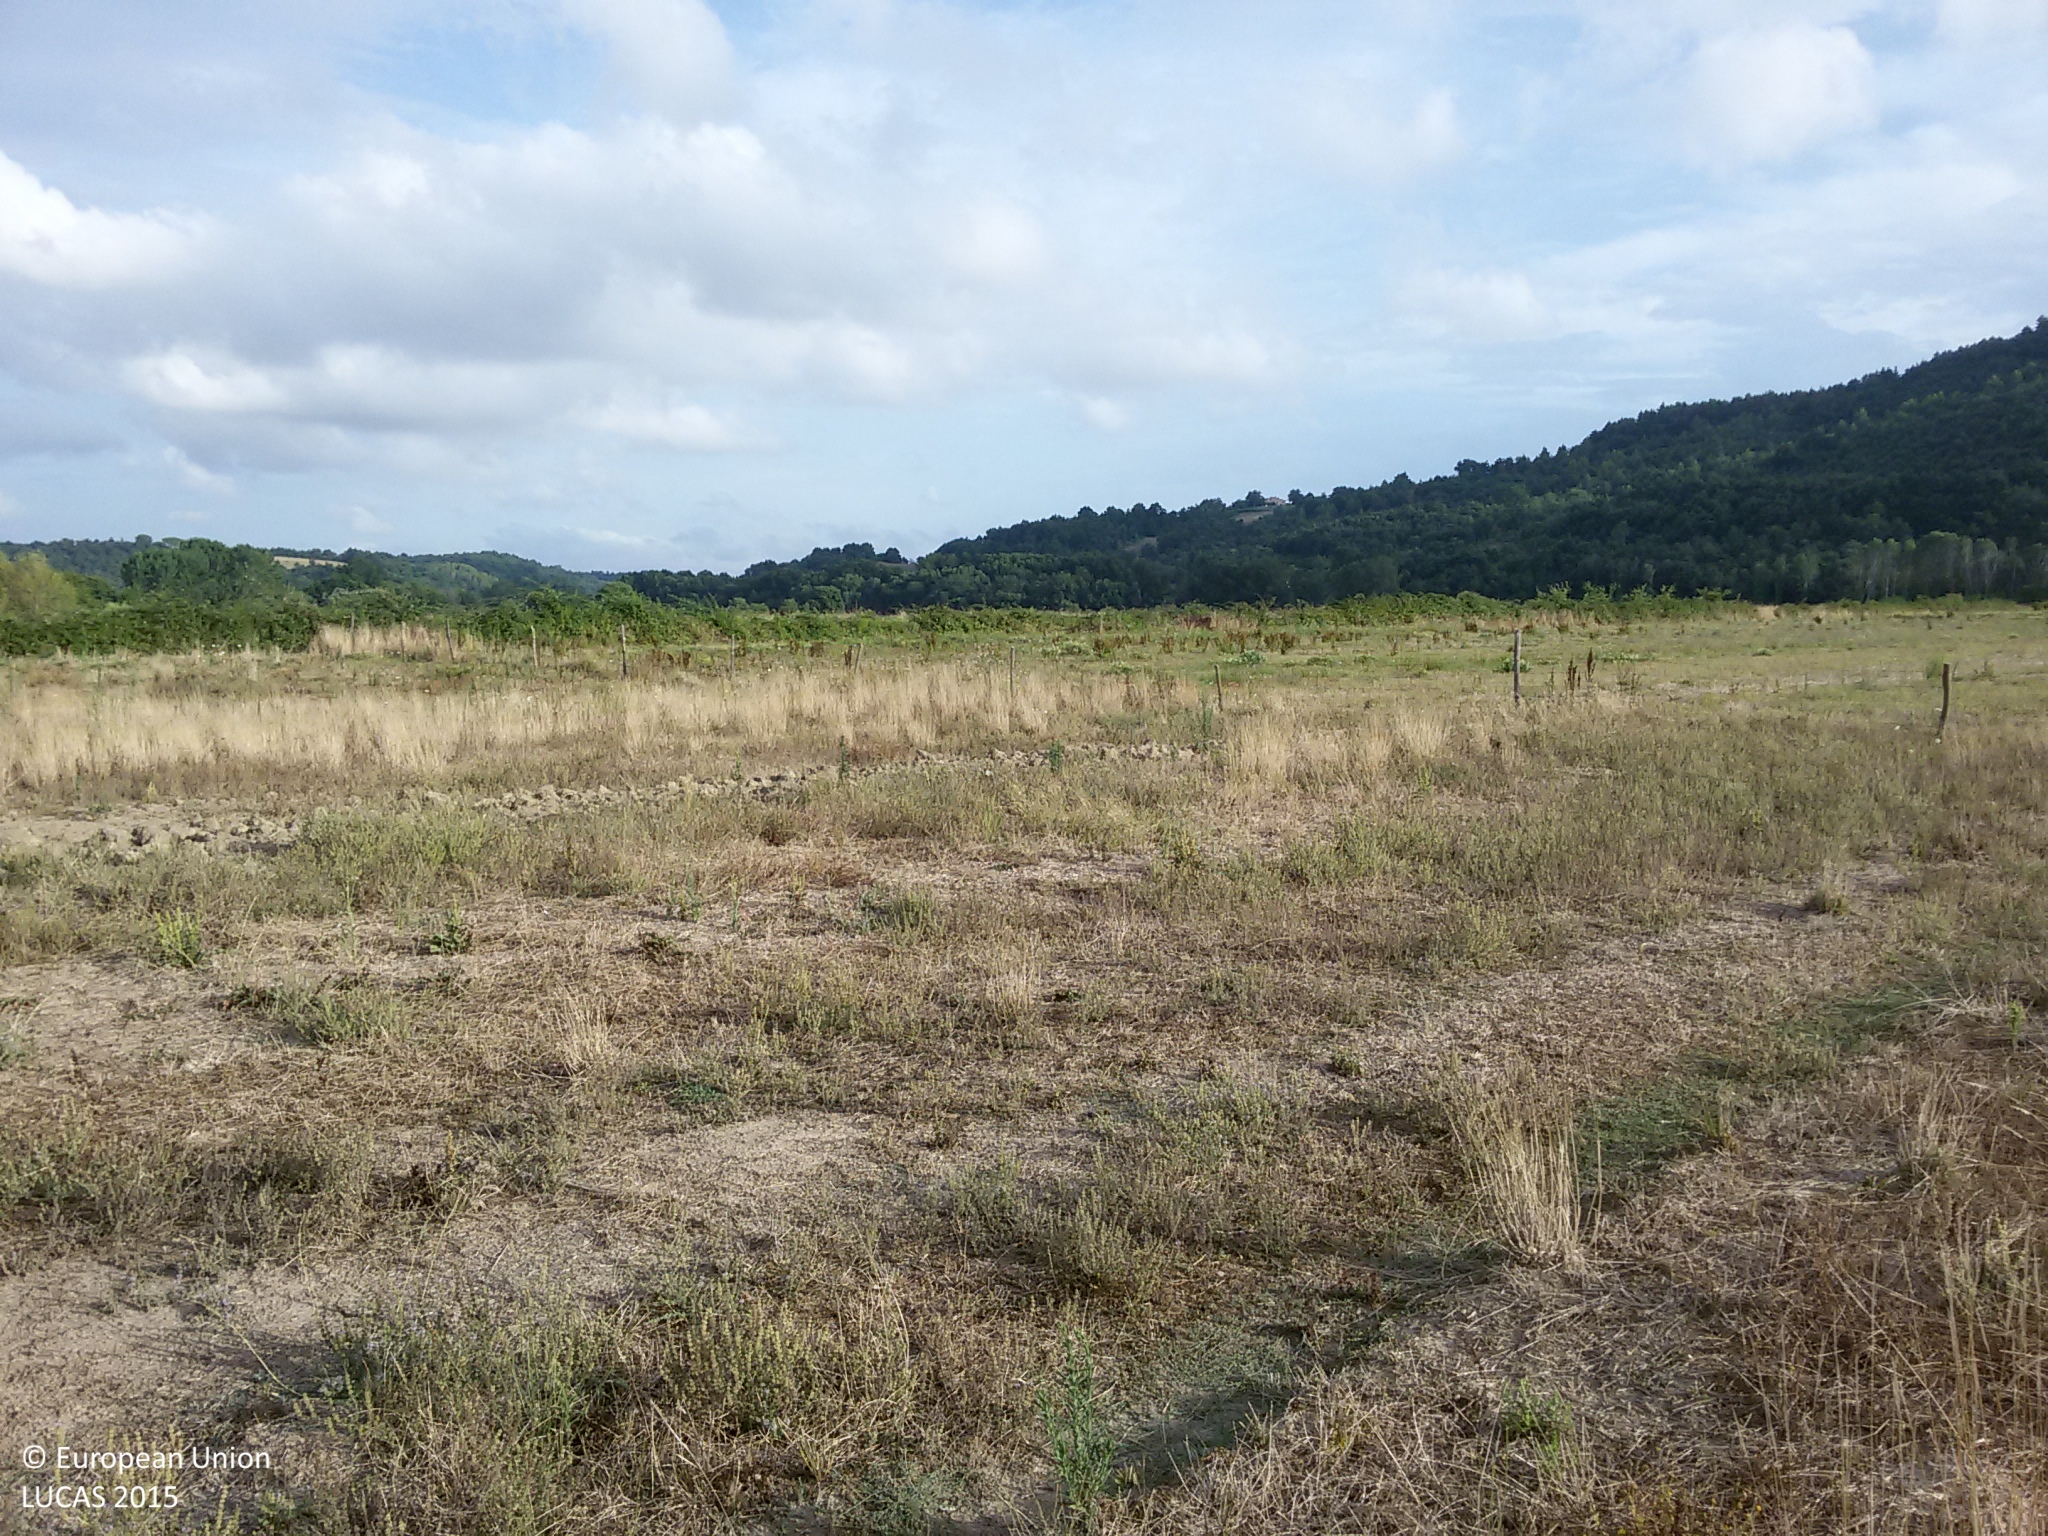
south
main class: Grassland
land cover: Grassland without tree/shrub cover
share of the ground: > 75 %
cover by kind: herbaceous plants 95 %, unconsolidated bare surface 5 %
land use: Agriculture (excluding fallow land and kitchen gardens)
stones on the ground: < 10 %
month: August
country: IT
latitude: 42.6054
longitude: 11.5914
